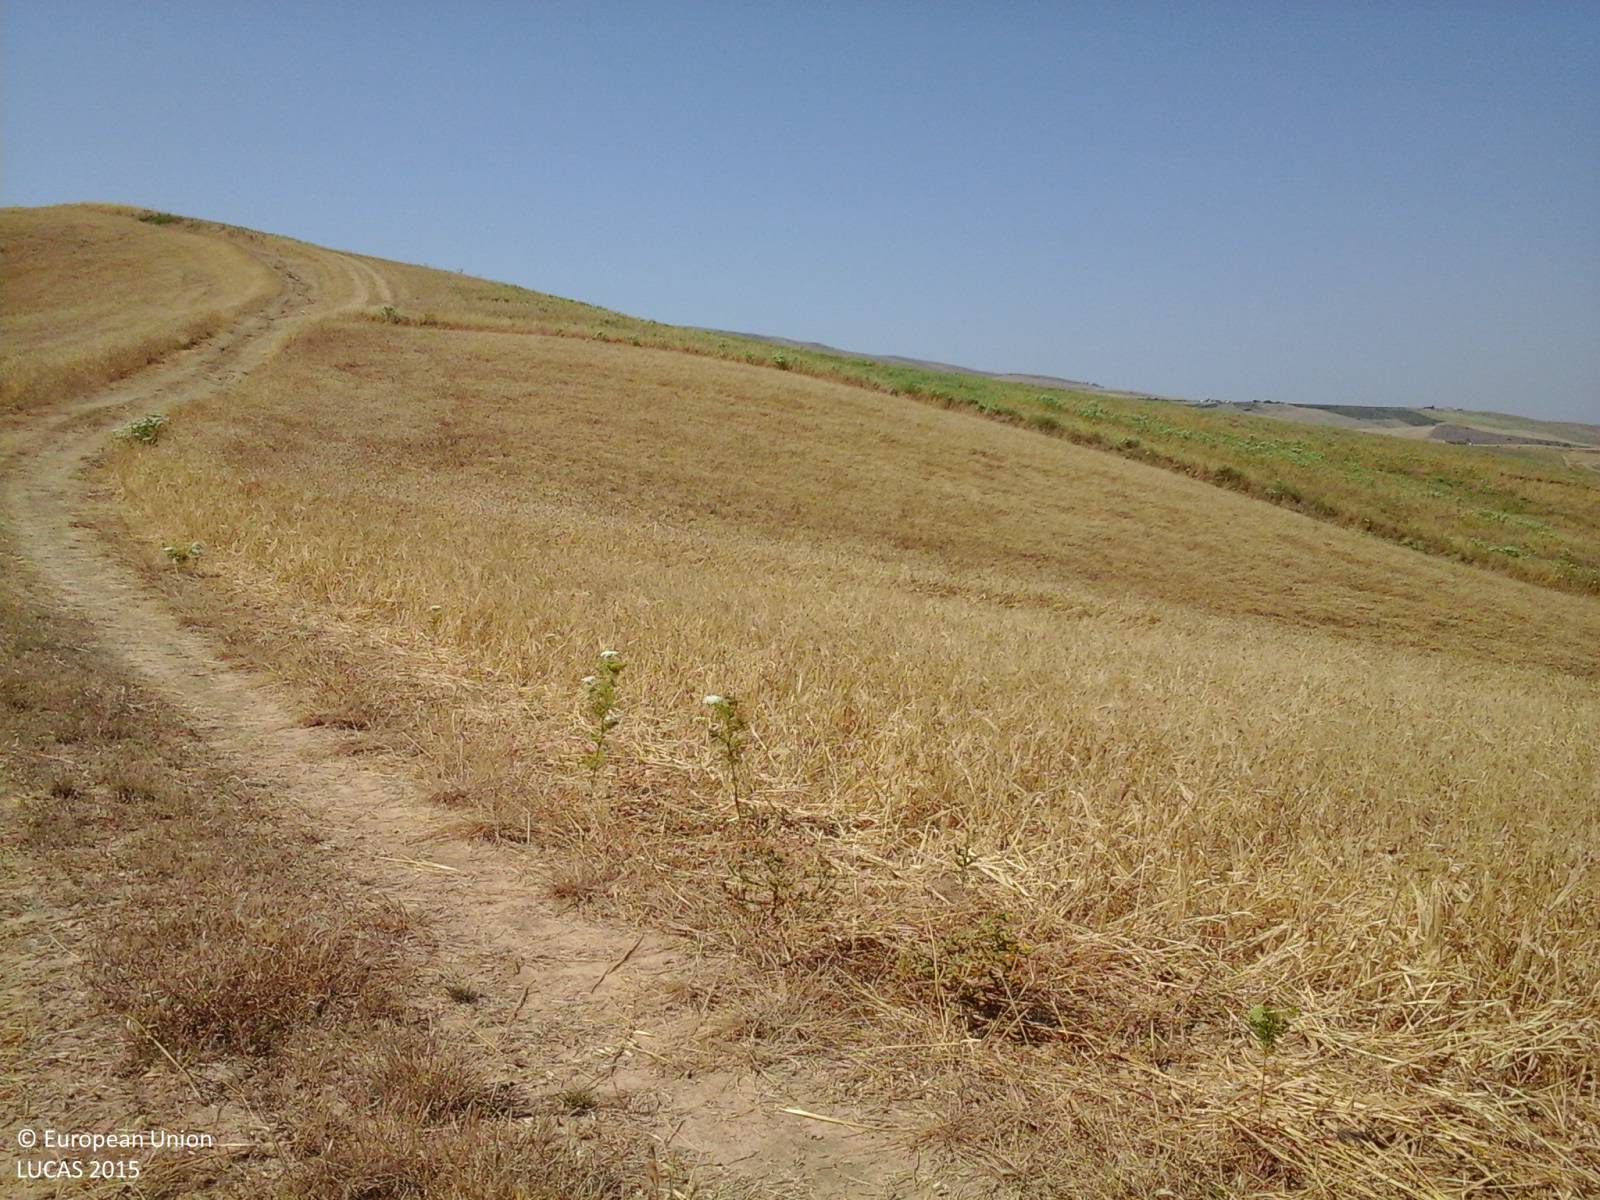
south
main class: Cropland
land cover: Barley
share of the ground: > 75 %
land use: Agriculture (excluding fallow land and kitchen gardens)
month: July
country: IT
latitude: 37.7675
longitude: 13.1666
